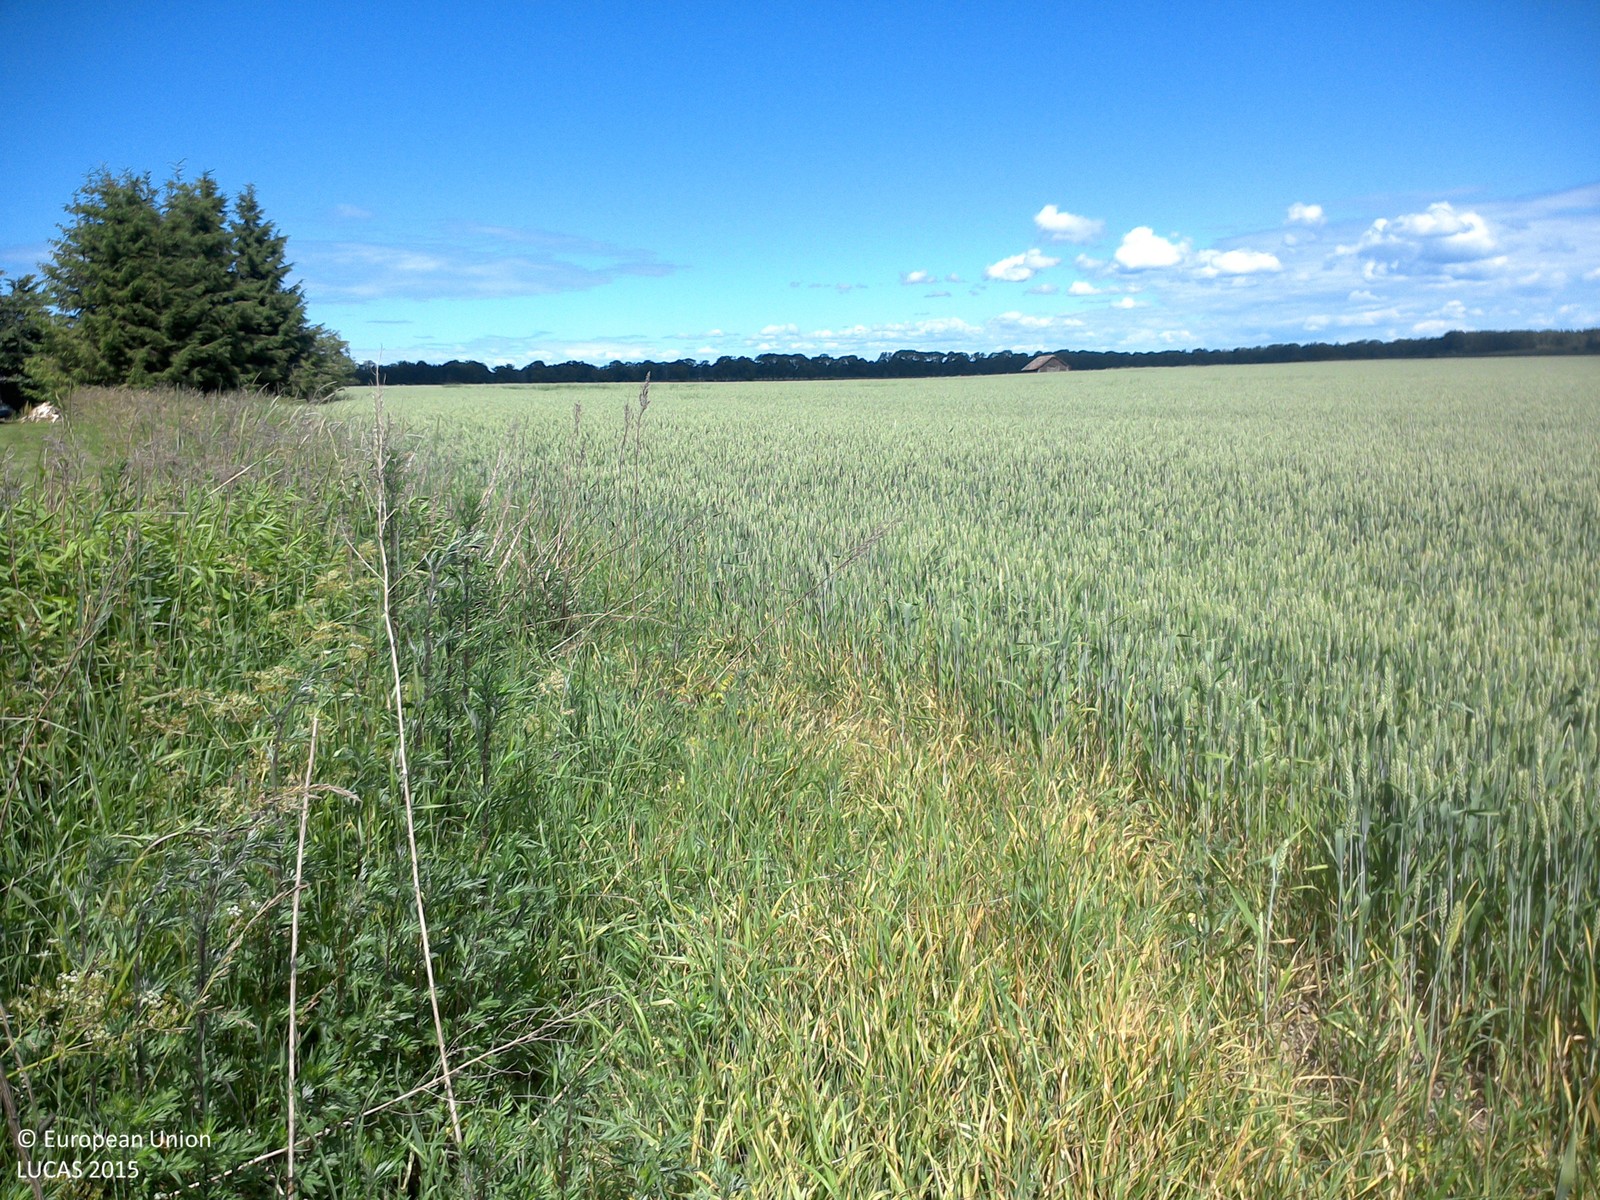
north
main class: Cropland
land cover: Common wheat
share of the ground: > 75 %
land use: Agriculture (excluding fallow land and kitchen gardens)
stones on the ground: < 10 %
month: July
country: SE
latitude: 58.3782
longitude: 15.4836
